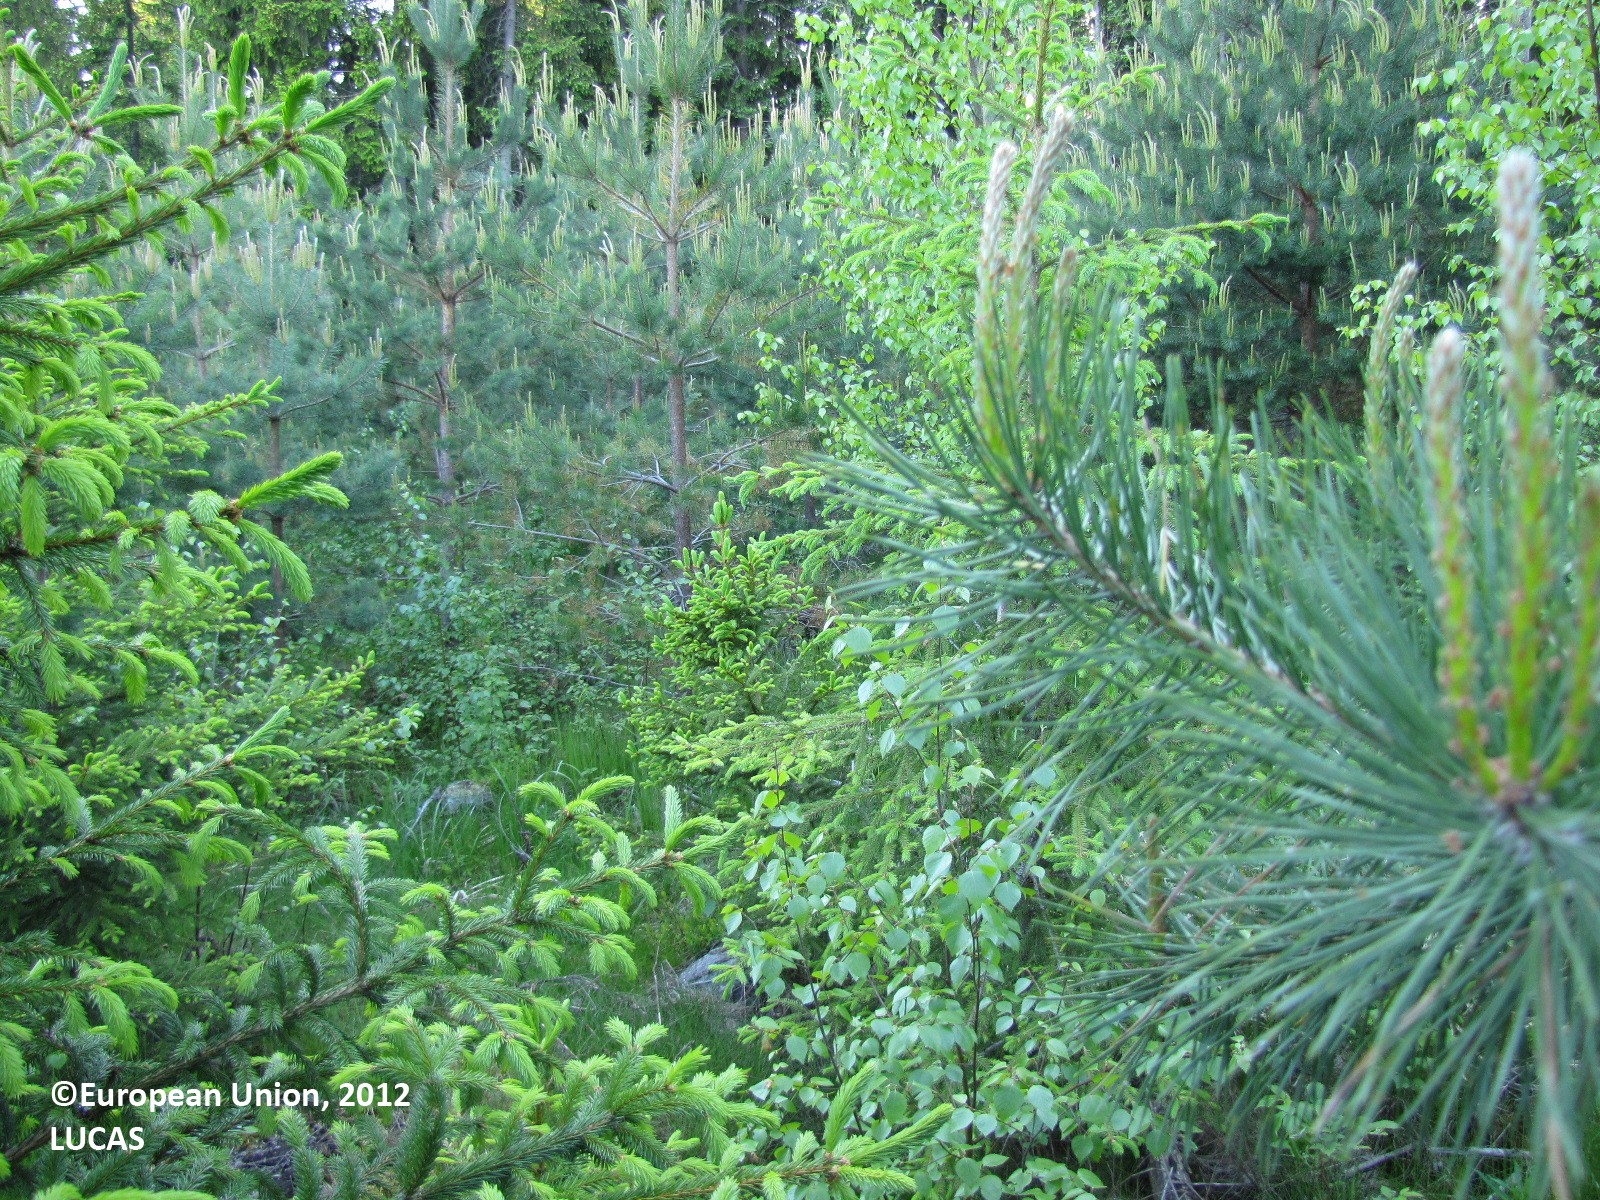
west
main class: Woodland
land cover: Pine dominated mixed woodland
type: boreal forest
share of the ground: 25 - 50 %
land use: Forestry
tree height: < 5 m
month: June
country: FI
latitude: 61.2337
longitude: 22.8682
